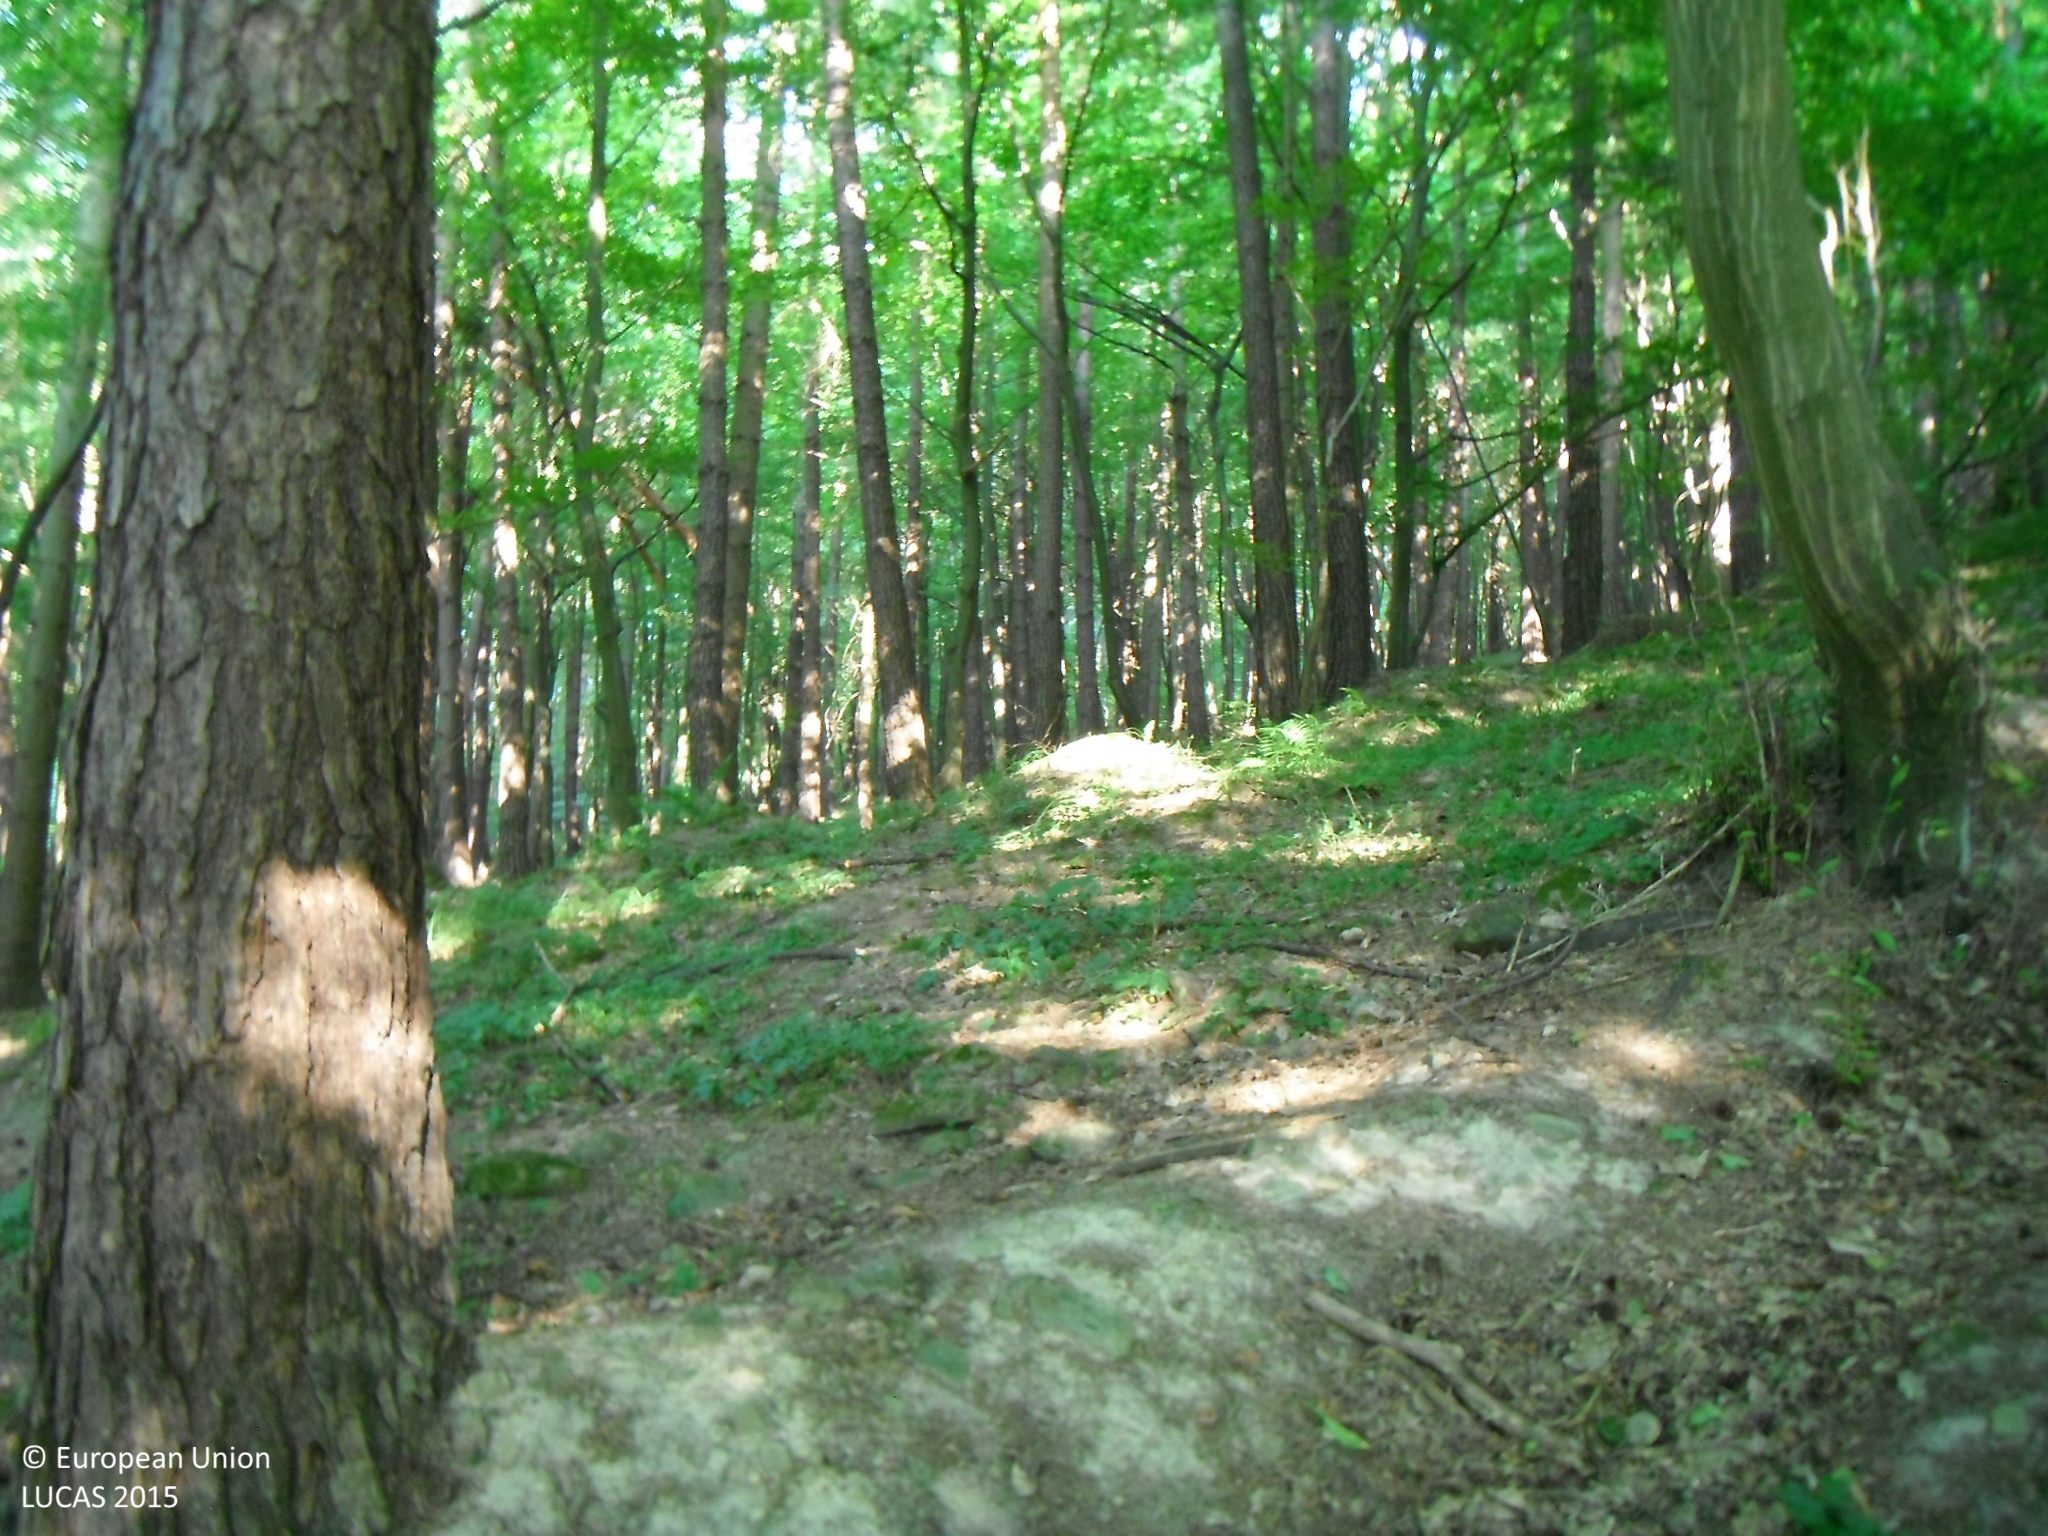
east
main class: Woodland
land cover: Pine dominated mixed woodland
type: hemiboreal forest and nemoral coniferous forest and mixed broadleaved-coniferous forest
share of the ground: > 75 %
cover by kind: coniferous forest trees 50 %, broadleaved forest trees 50 %
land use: Forestry
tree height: > 5 m
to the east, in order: Pine dominated mixed woodland; Spruce dominated coniferous woodland; Grassland with sparse tree/shrub cover; Tracks; Grassland with sparse tree/shrub cover; Broadleaved woodland; Grassland without tree/shrub cover
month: July
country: SK
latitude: 49.1091
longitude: 18.4699
